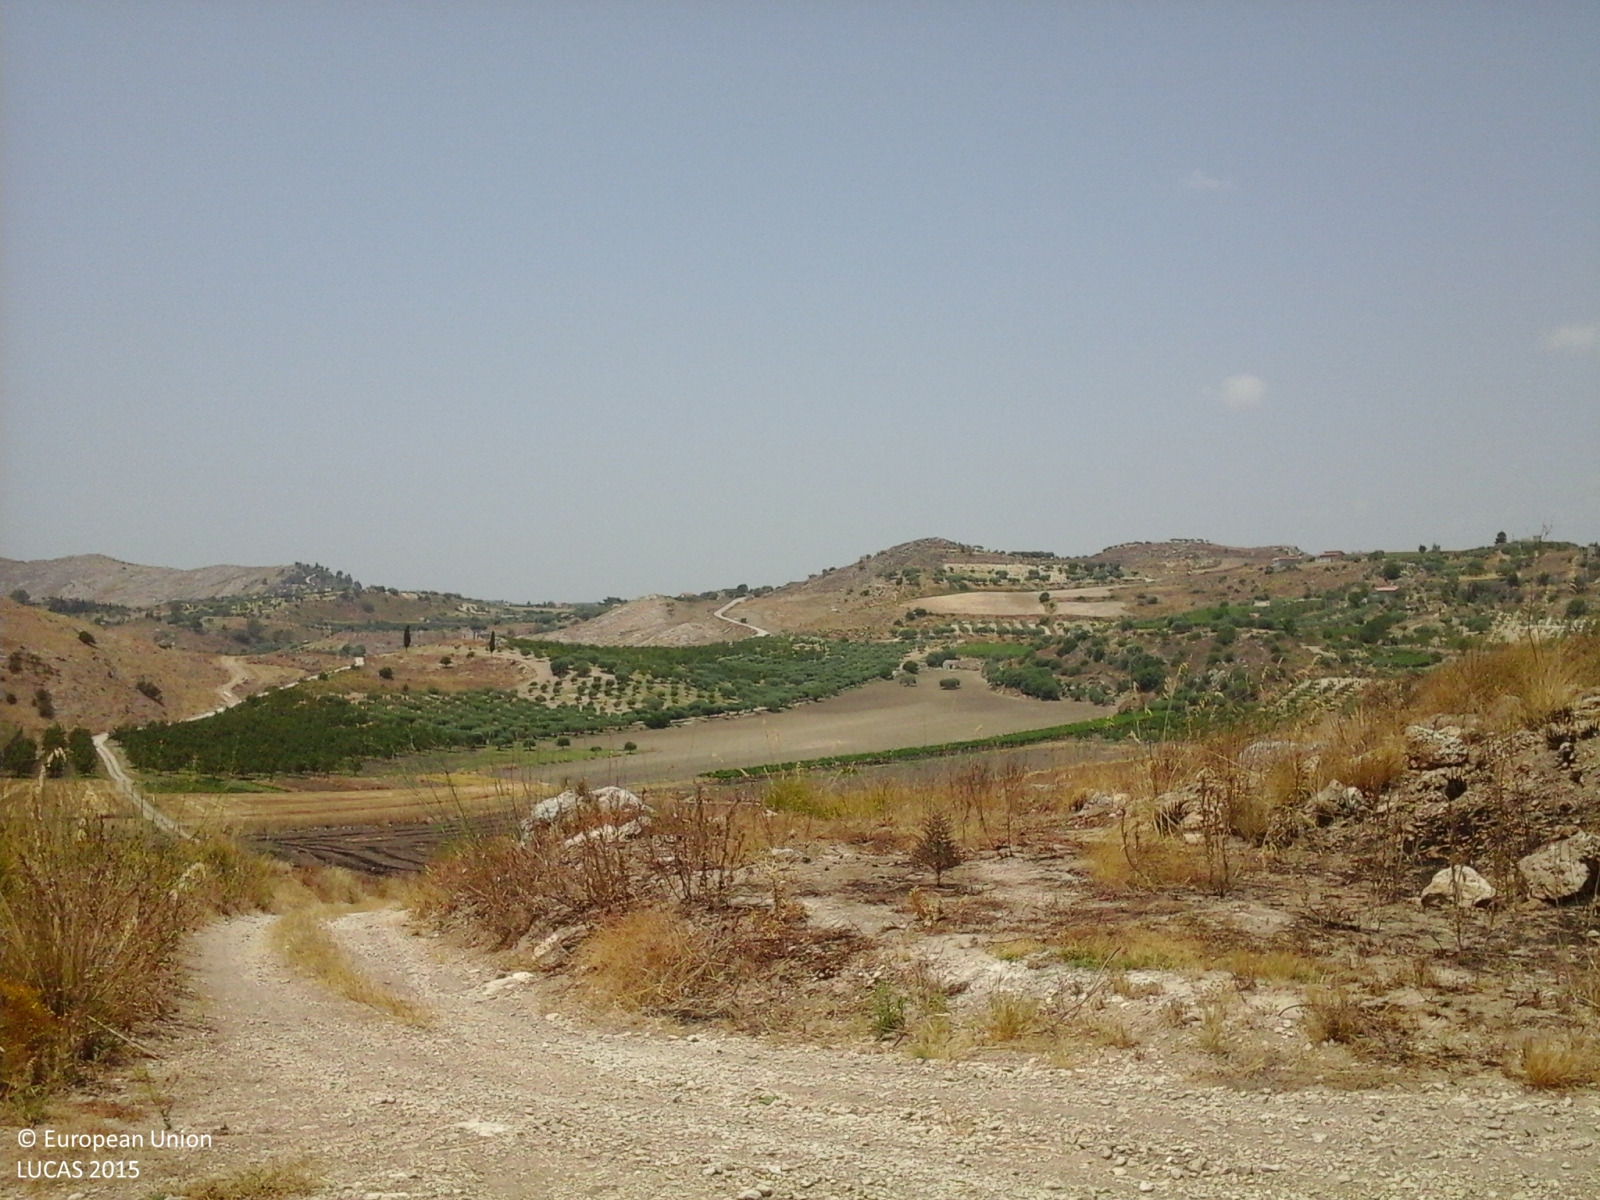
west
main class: Grassland
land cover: Grassland without tree/shrub cover
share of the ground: > 75 %
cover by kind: herbaceous plants 75 %, consolidated bare surface 25 %
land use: Semi-natural and natural areas not in use
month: July
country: IT
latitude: 37.3162
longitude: 14.0424
